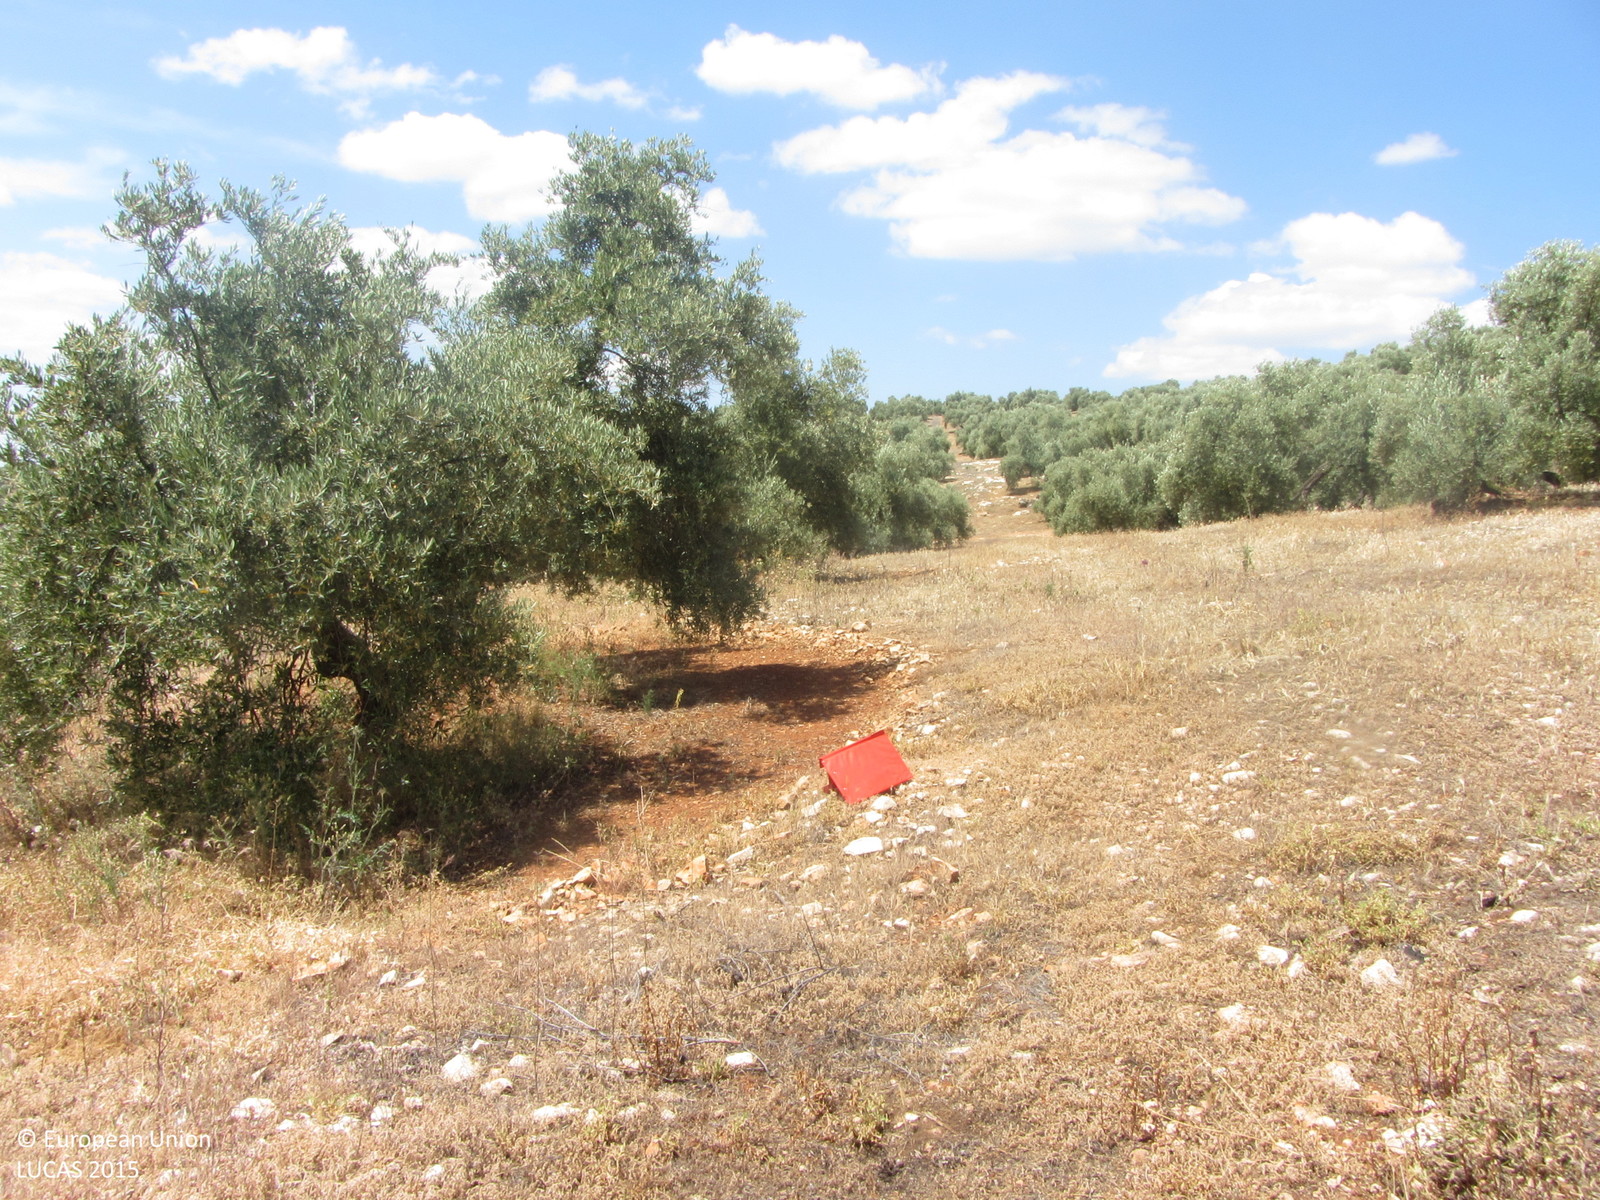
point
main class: Cropland
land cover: Olive groves
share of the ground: 25 - 50 %
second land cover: Spontaneously vegetated surfaces
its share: > 75 %
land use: Agriculture (excluding fallow land and kitchen gardens)
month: May
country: ES
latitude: 38.1665
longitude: -3.2987
